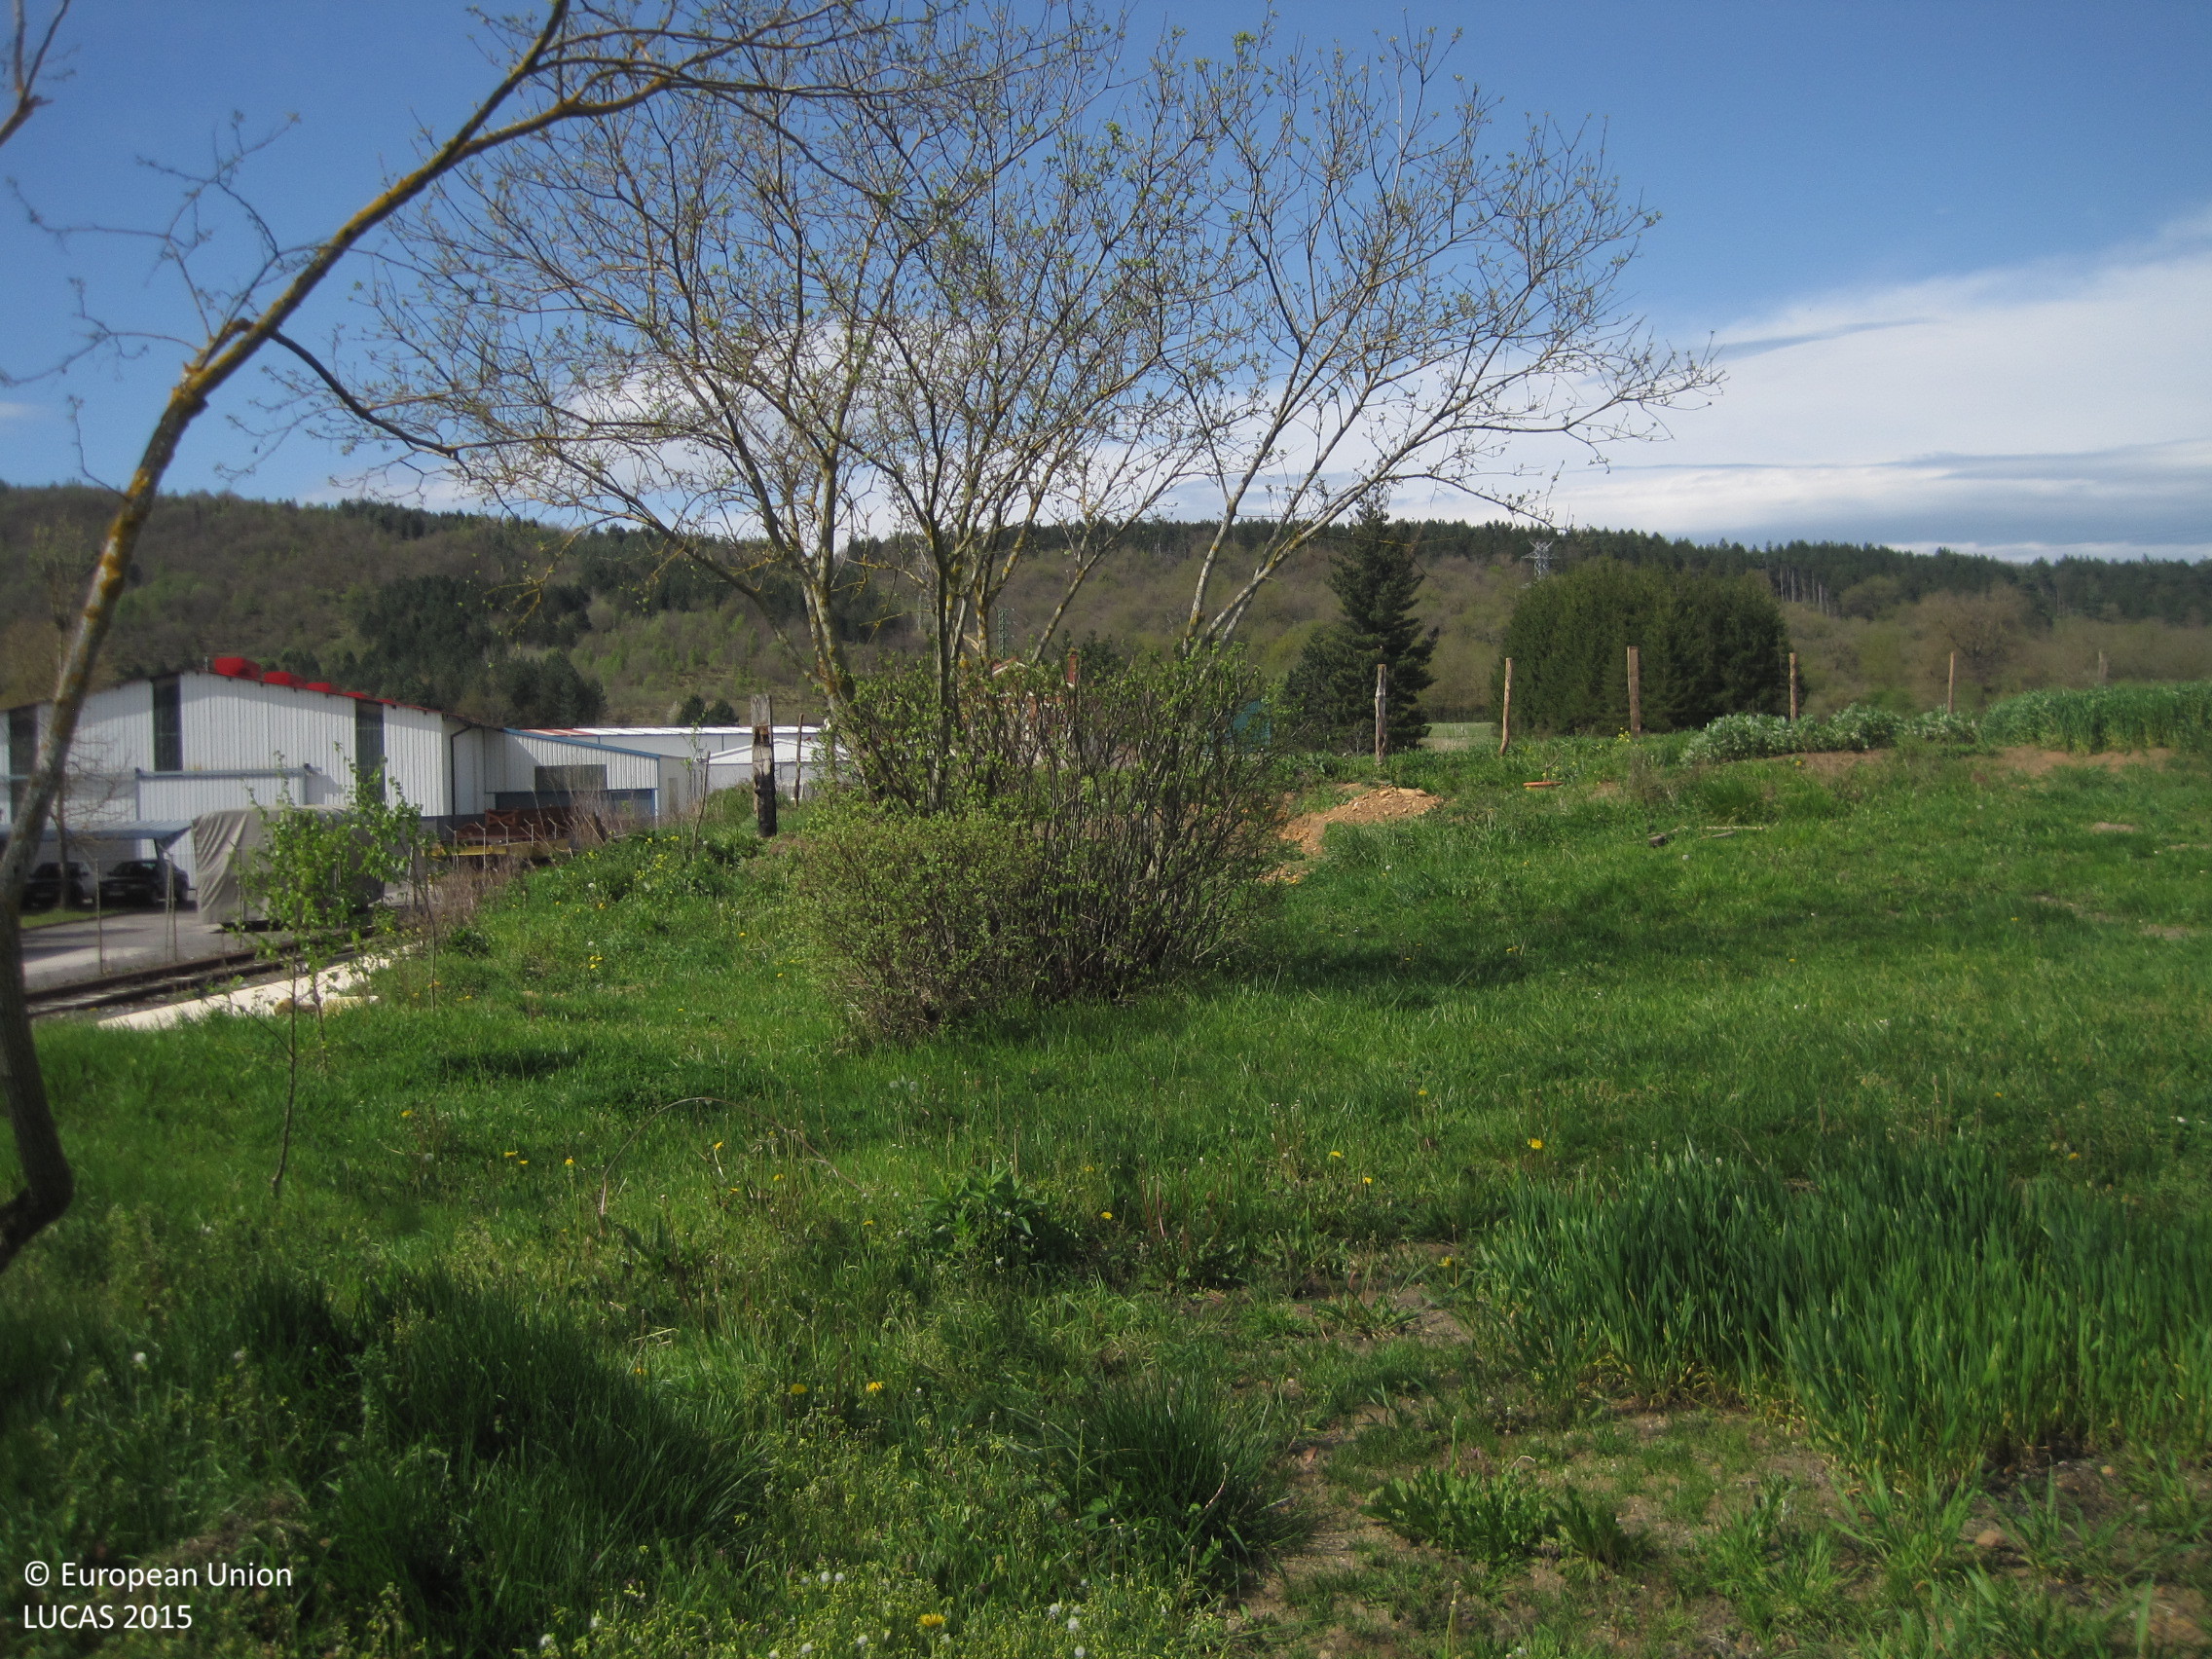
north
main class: Grassland
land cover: Grassland without tree/shrub cover
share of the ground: > 75 %
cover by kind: herbaceous plants 100 %
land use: Agriculture (excluding fallow land and kitchen gardens)
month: April
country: ES
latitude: 42.9006
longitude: -2.1826
